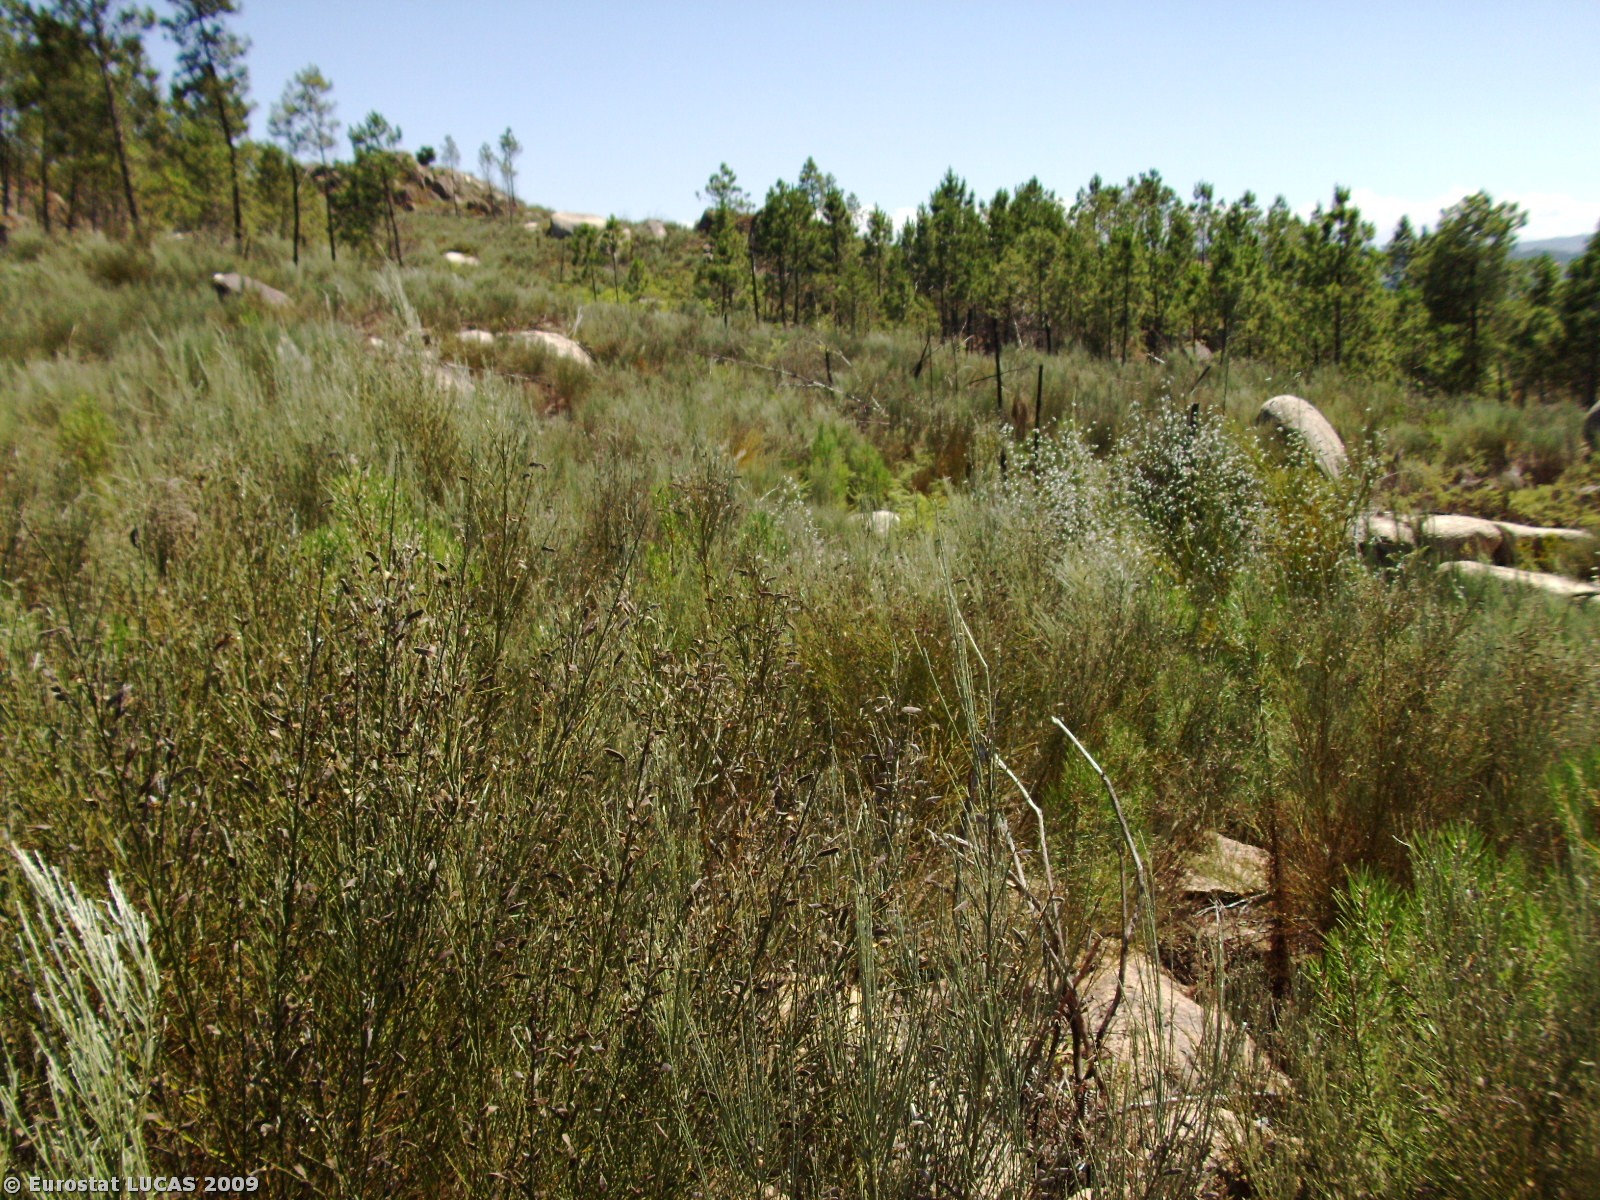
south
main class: Shrubland
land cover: Shrubland without tree cover
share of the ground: 50 - 75 %
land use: Unused
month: July
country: PT
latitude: 40.6851
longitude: -7.6414
